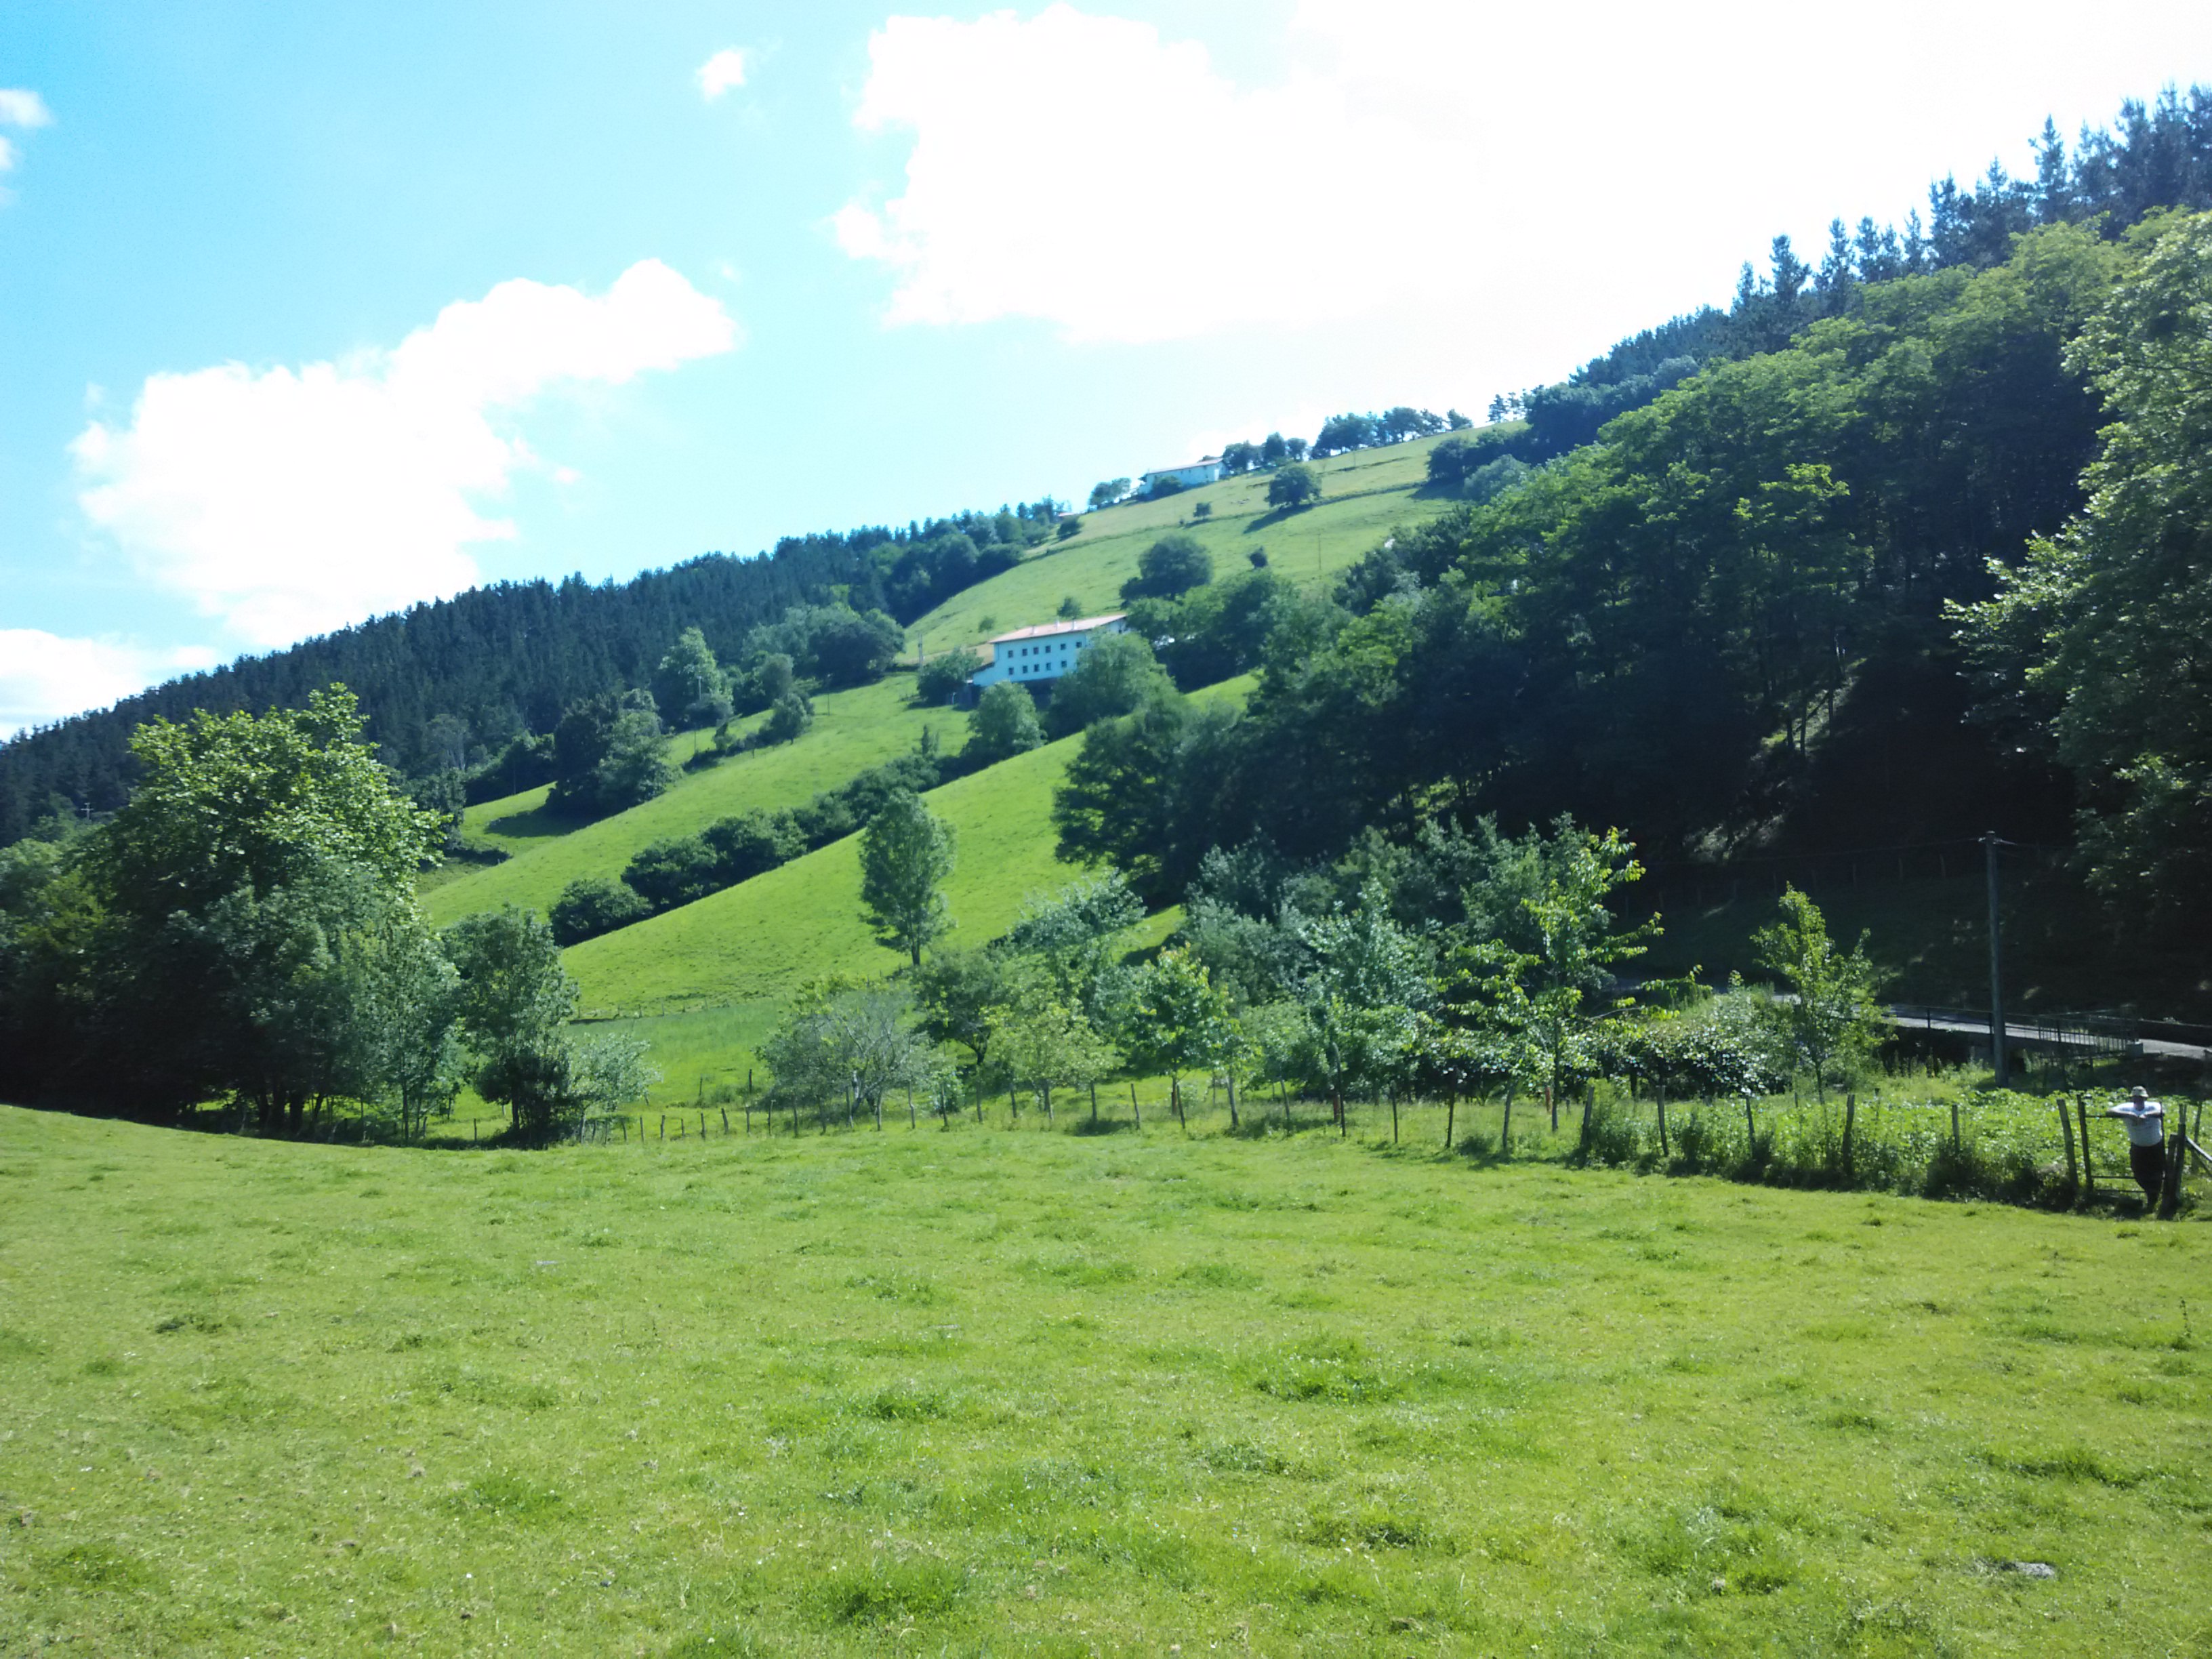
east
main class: Grassland
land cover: Grassland without tree/shrub cover
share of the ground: > 75 %
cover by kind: herbaceous plants 100 %
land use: Agriculture (excluding fallow land and kitchen gardens)
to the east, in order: Grassland without tree/shrub cover; Fences; Grassland without tree/shrub cover; Fences; Nuts trees; Grassland without tree/shrub cover; Artificial constructions in urban areas; Grassland without tree/shrub cover; Fences; Broadleaved woodland; Fences; Paved roads, cycling and walking lanes; Fences; Broadleaved woodland; Fences; Paved roads, cycling and walking lanes; Fences; Broadleaved woodland; Fences; Grassland without tree/shrub cover
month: June
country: ES
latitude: 43.2267
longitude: -2.5002
